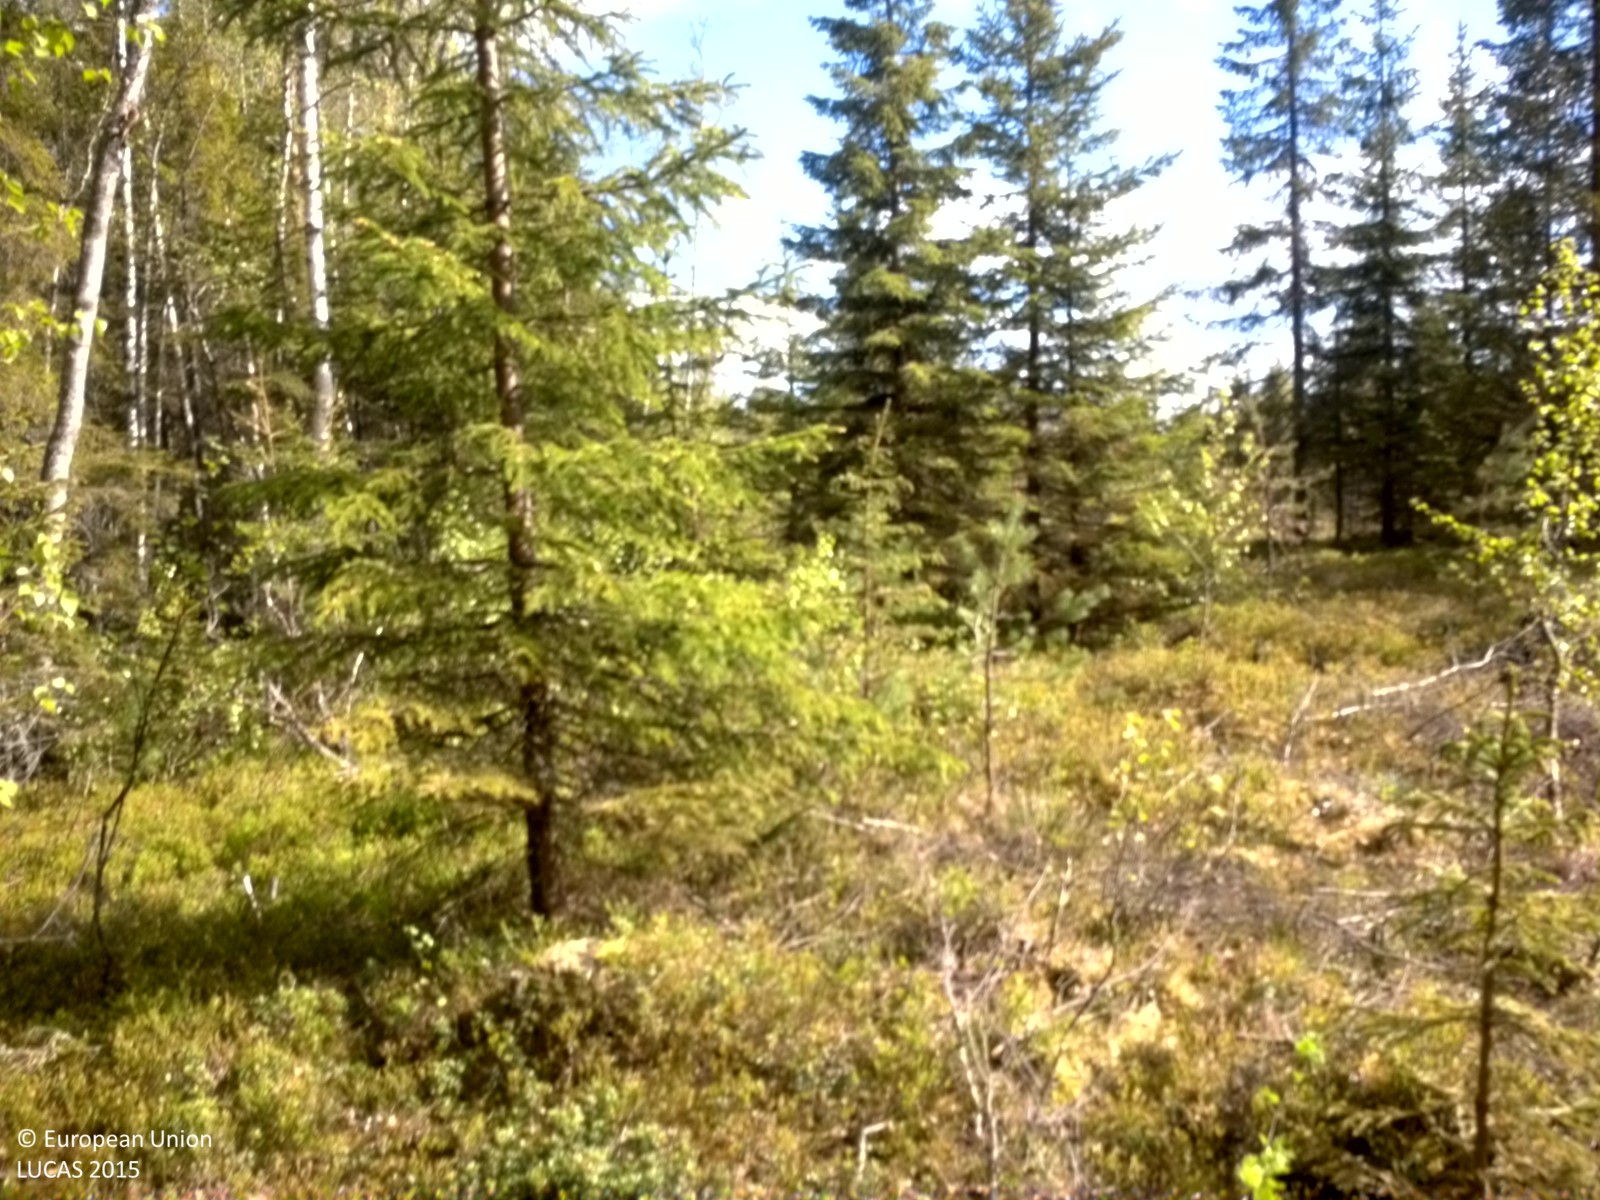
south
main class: Woodland
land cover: Spruce dominated mixed woodland
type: boreal forest
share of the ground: 50 - 75 %
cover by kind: herbaceous plants 50 %, coniferous forest trees 30 %, broadleaved forest trees 20 %
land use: Forestry
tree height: > 5 m
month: June
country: SE
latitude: 63.9490
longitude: 20.0819
